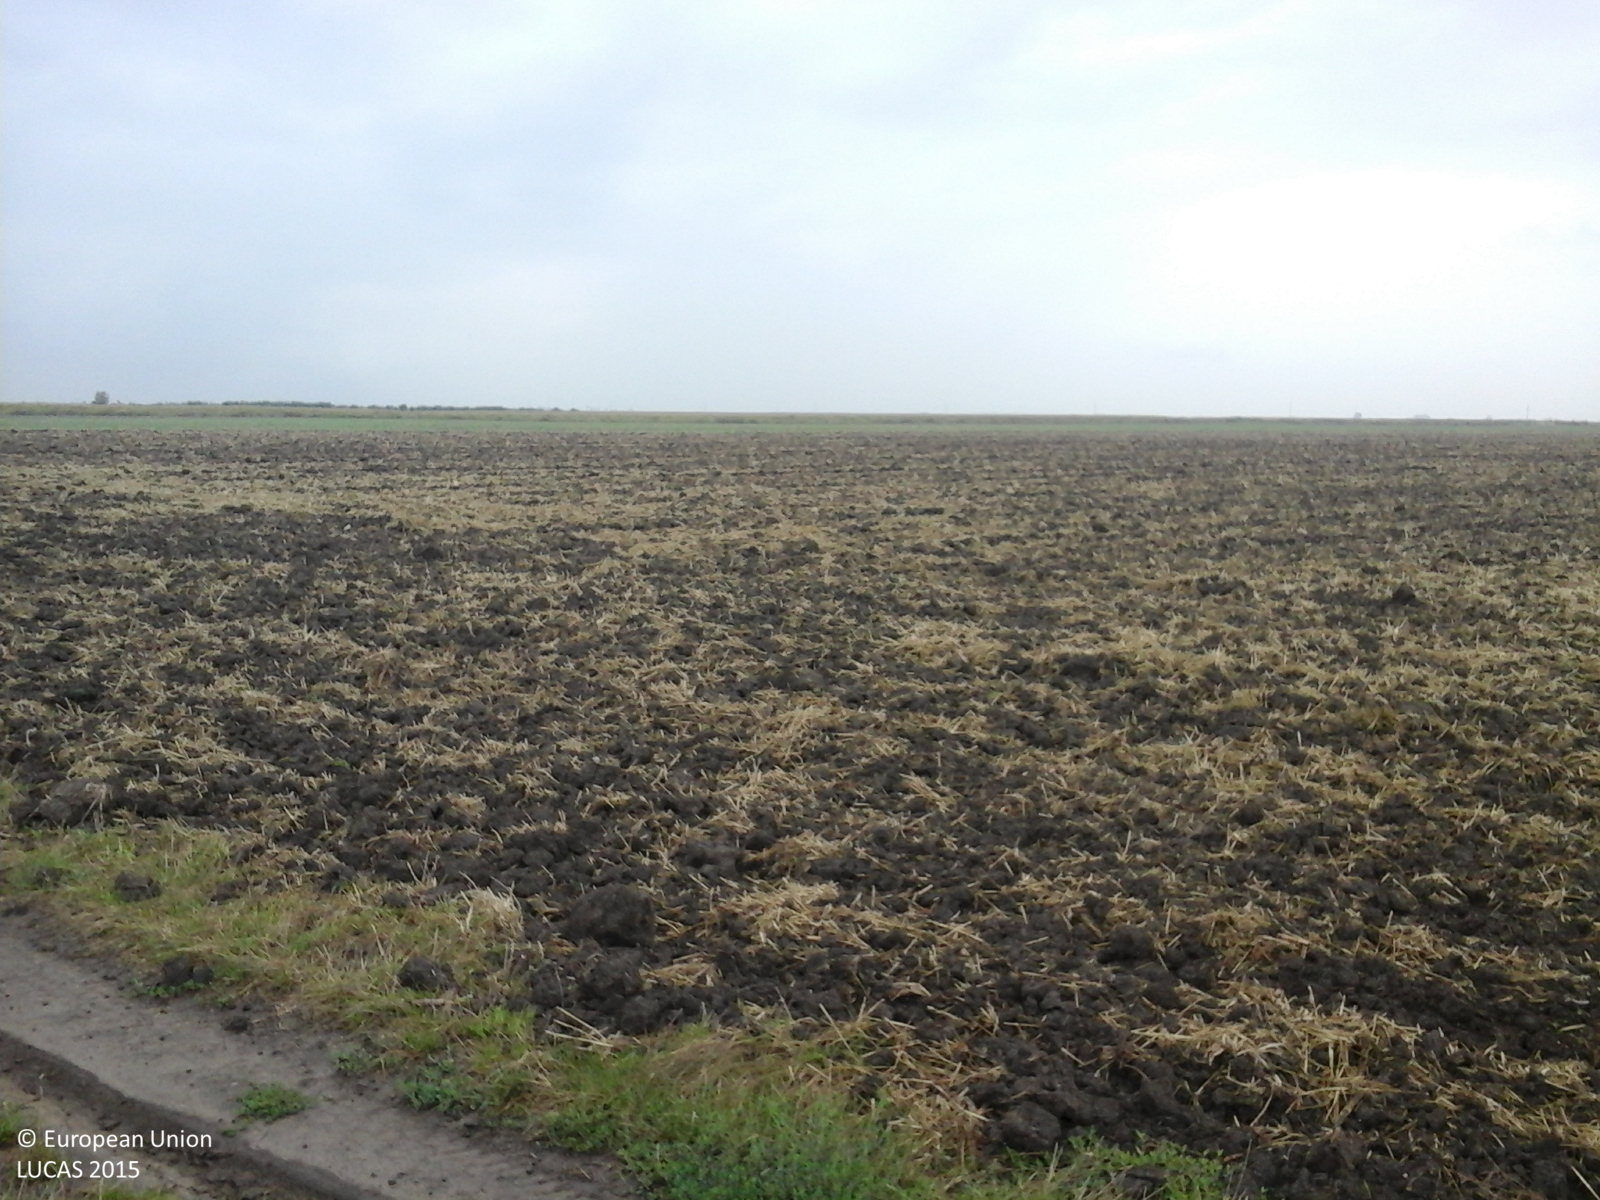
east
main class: Cropland
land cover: Sunflower
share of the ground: > 75 %
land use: Agriculture (excluding fallow land and kitchen gardens)
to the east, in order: Sunflower
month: August
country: RO
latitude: 45.6344
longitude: 21.0214
